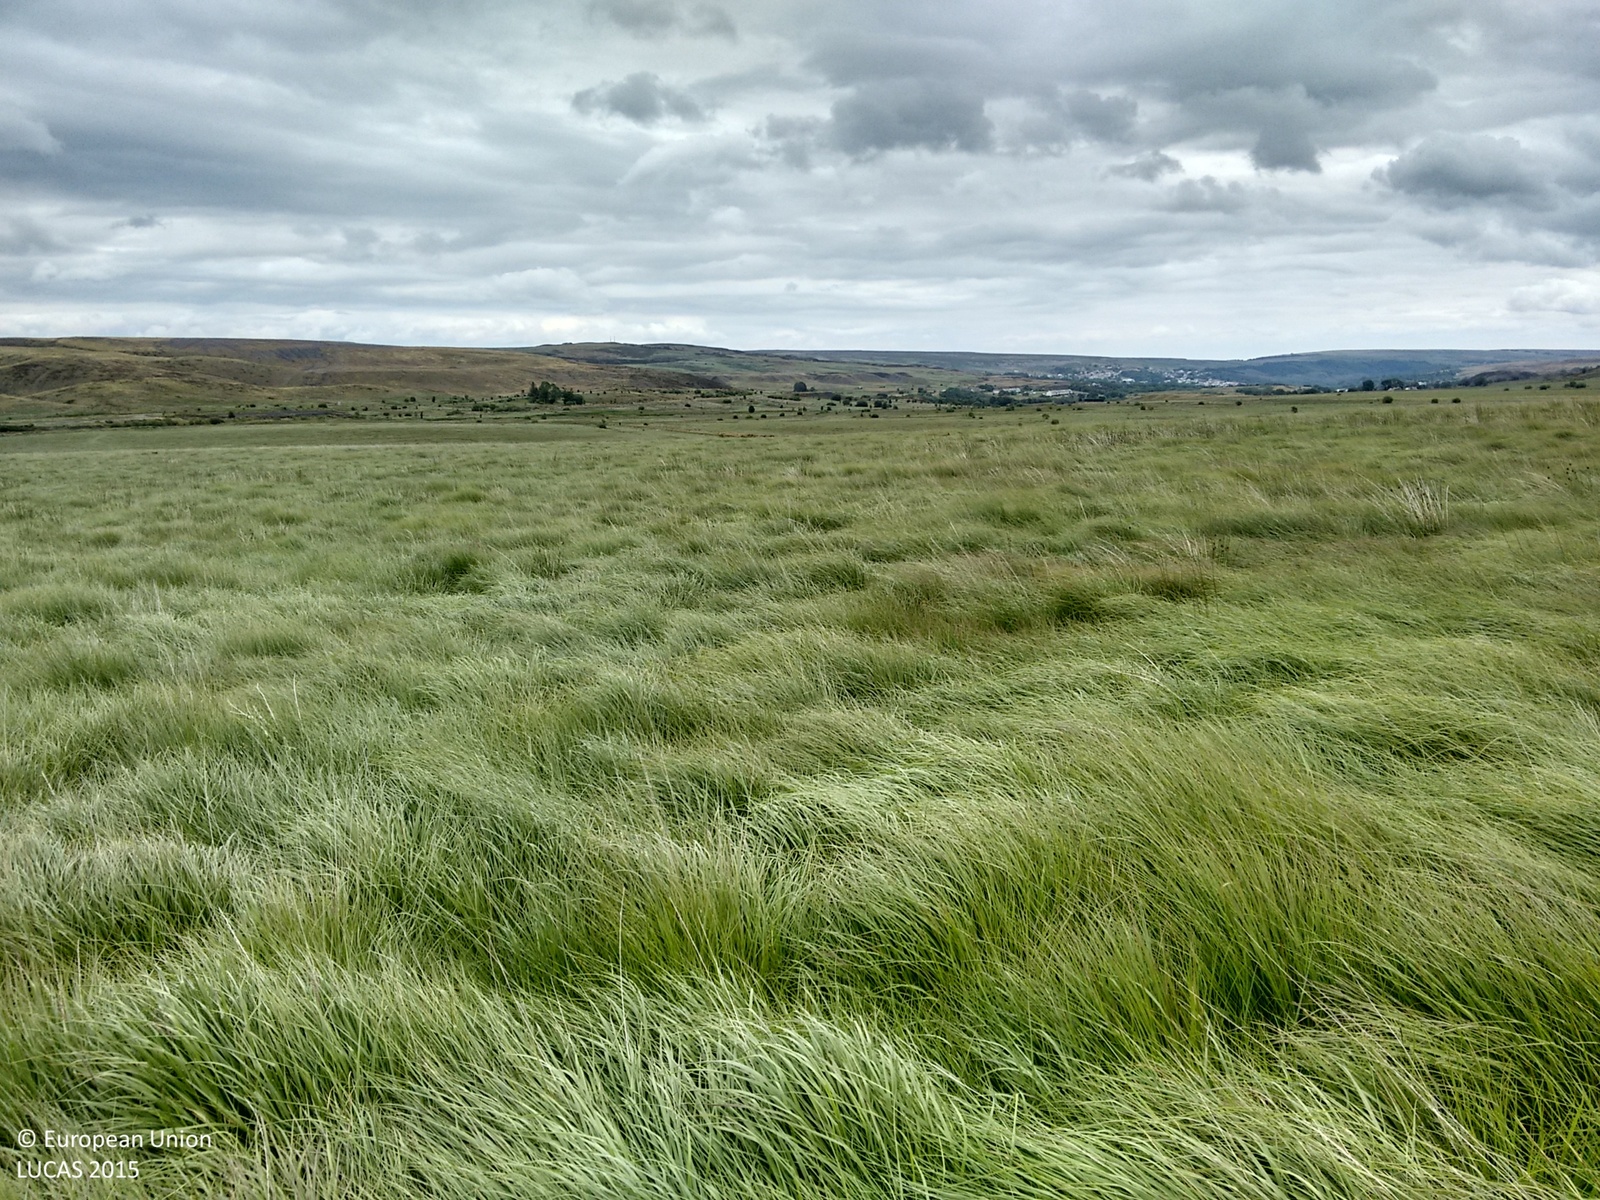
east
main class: Grassland
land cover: Grassland without tree/shrub cover
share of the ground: > 75 %
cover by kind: herbaceous plants 100 %
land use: Semi-natural and natural areas not in use
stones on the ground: < 10 %
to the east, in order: Grassland without tree/shrub cover
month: July
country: GB
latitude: 51.7888
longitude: -3.1400
